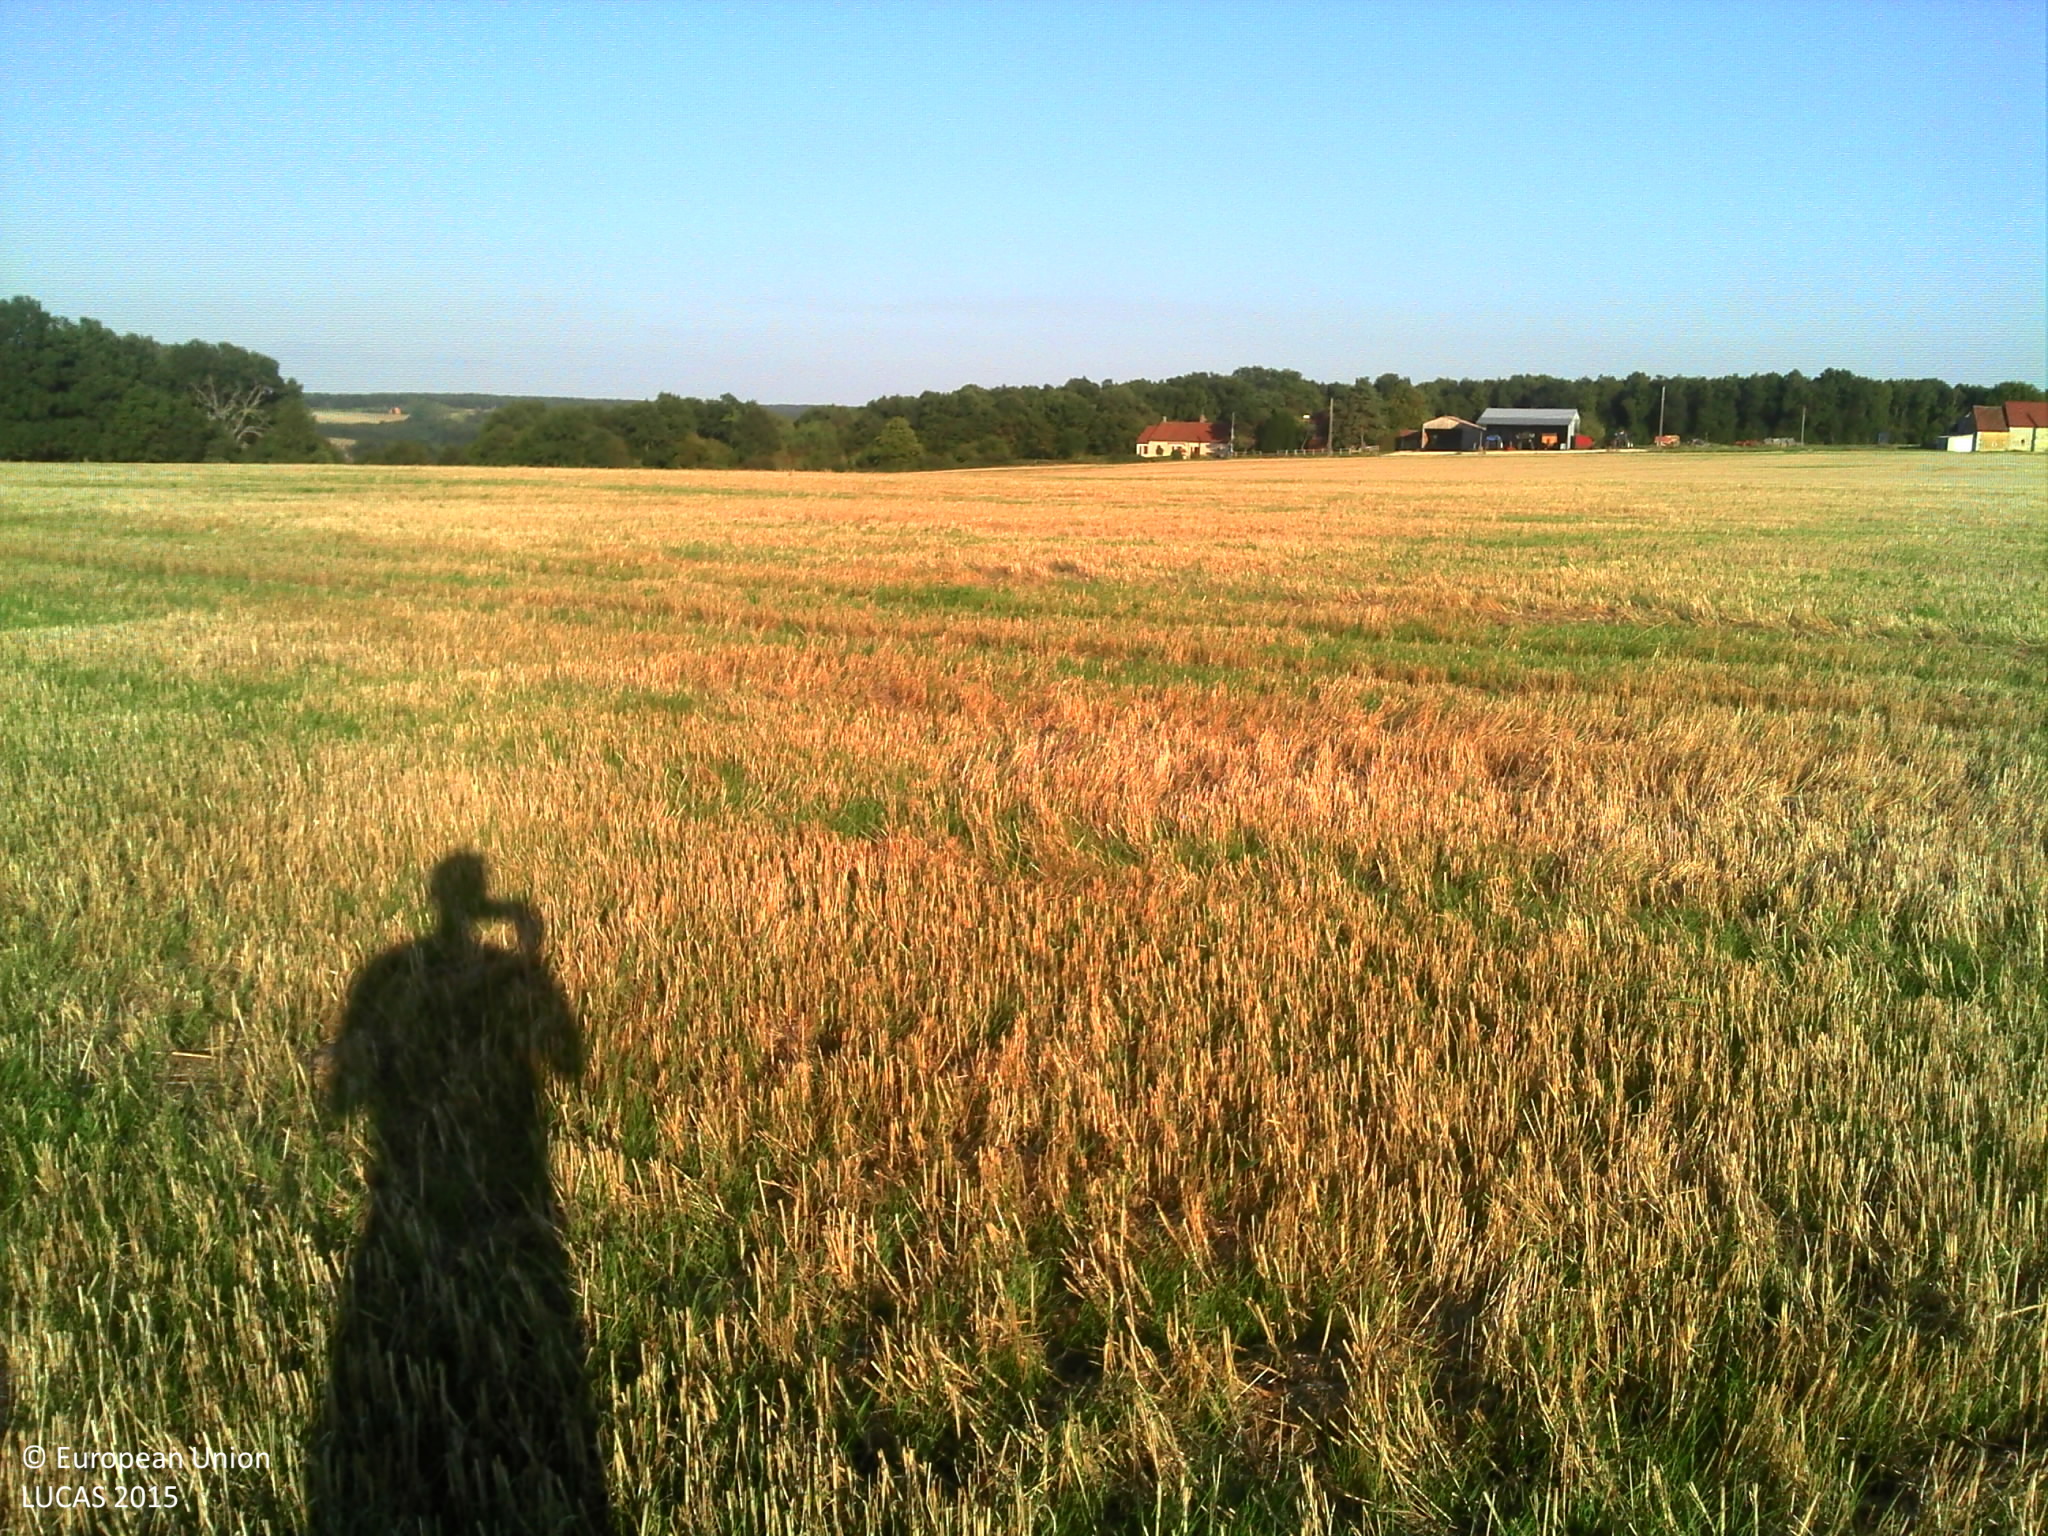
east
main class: Cropland
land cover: Common wheat
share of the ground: > 75 %
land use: Agriculture (excluding fallow land and kitchen gardens)
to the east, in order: Common wheat
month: September
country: FR
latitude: 47.0284
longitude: 1.5273
